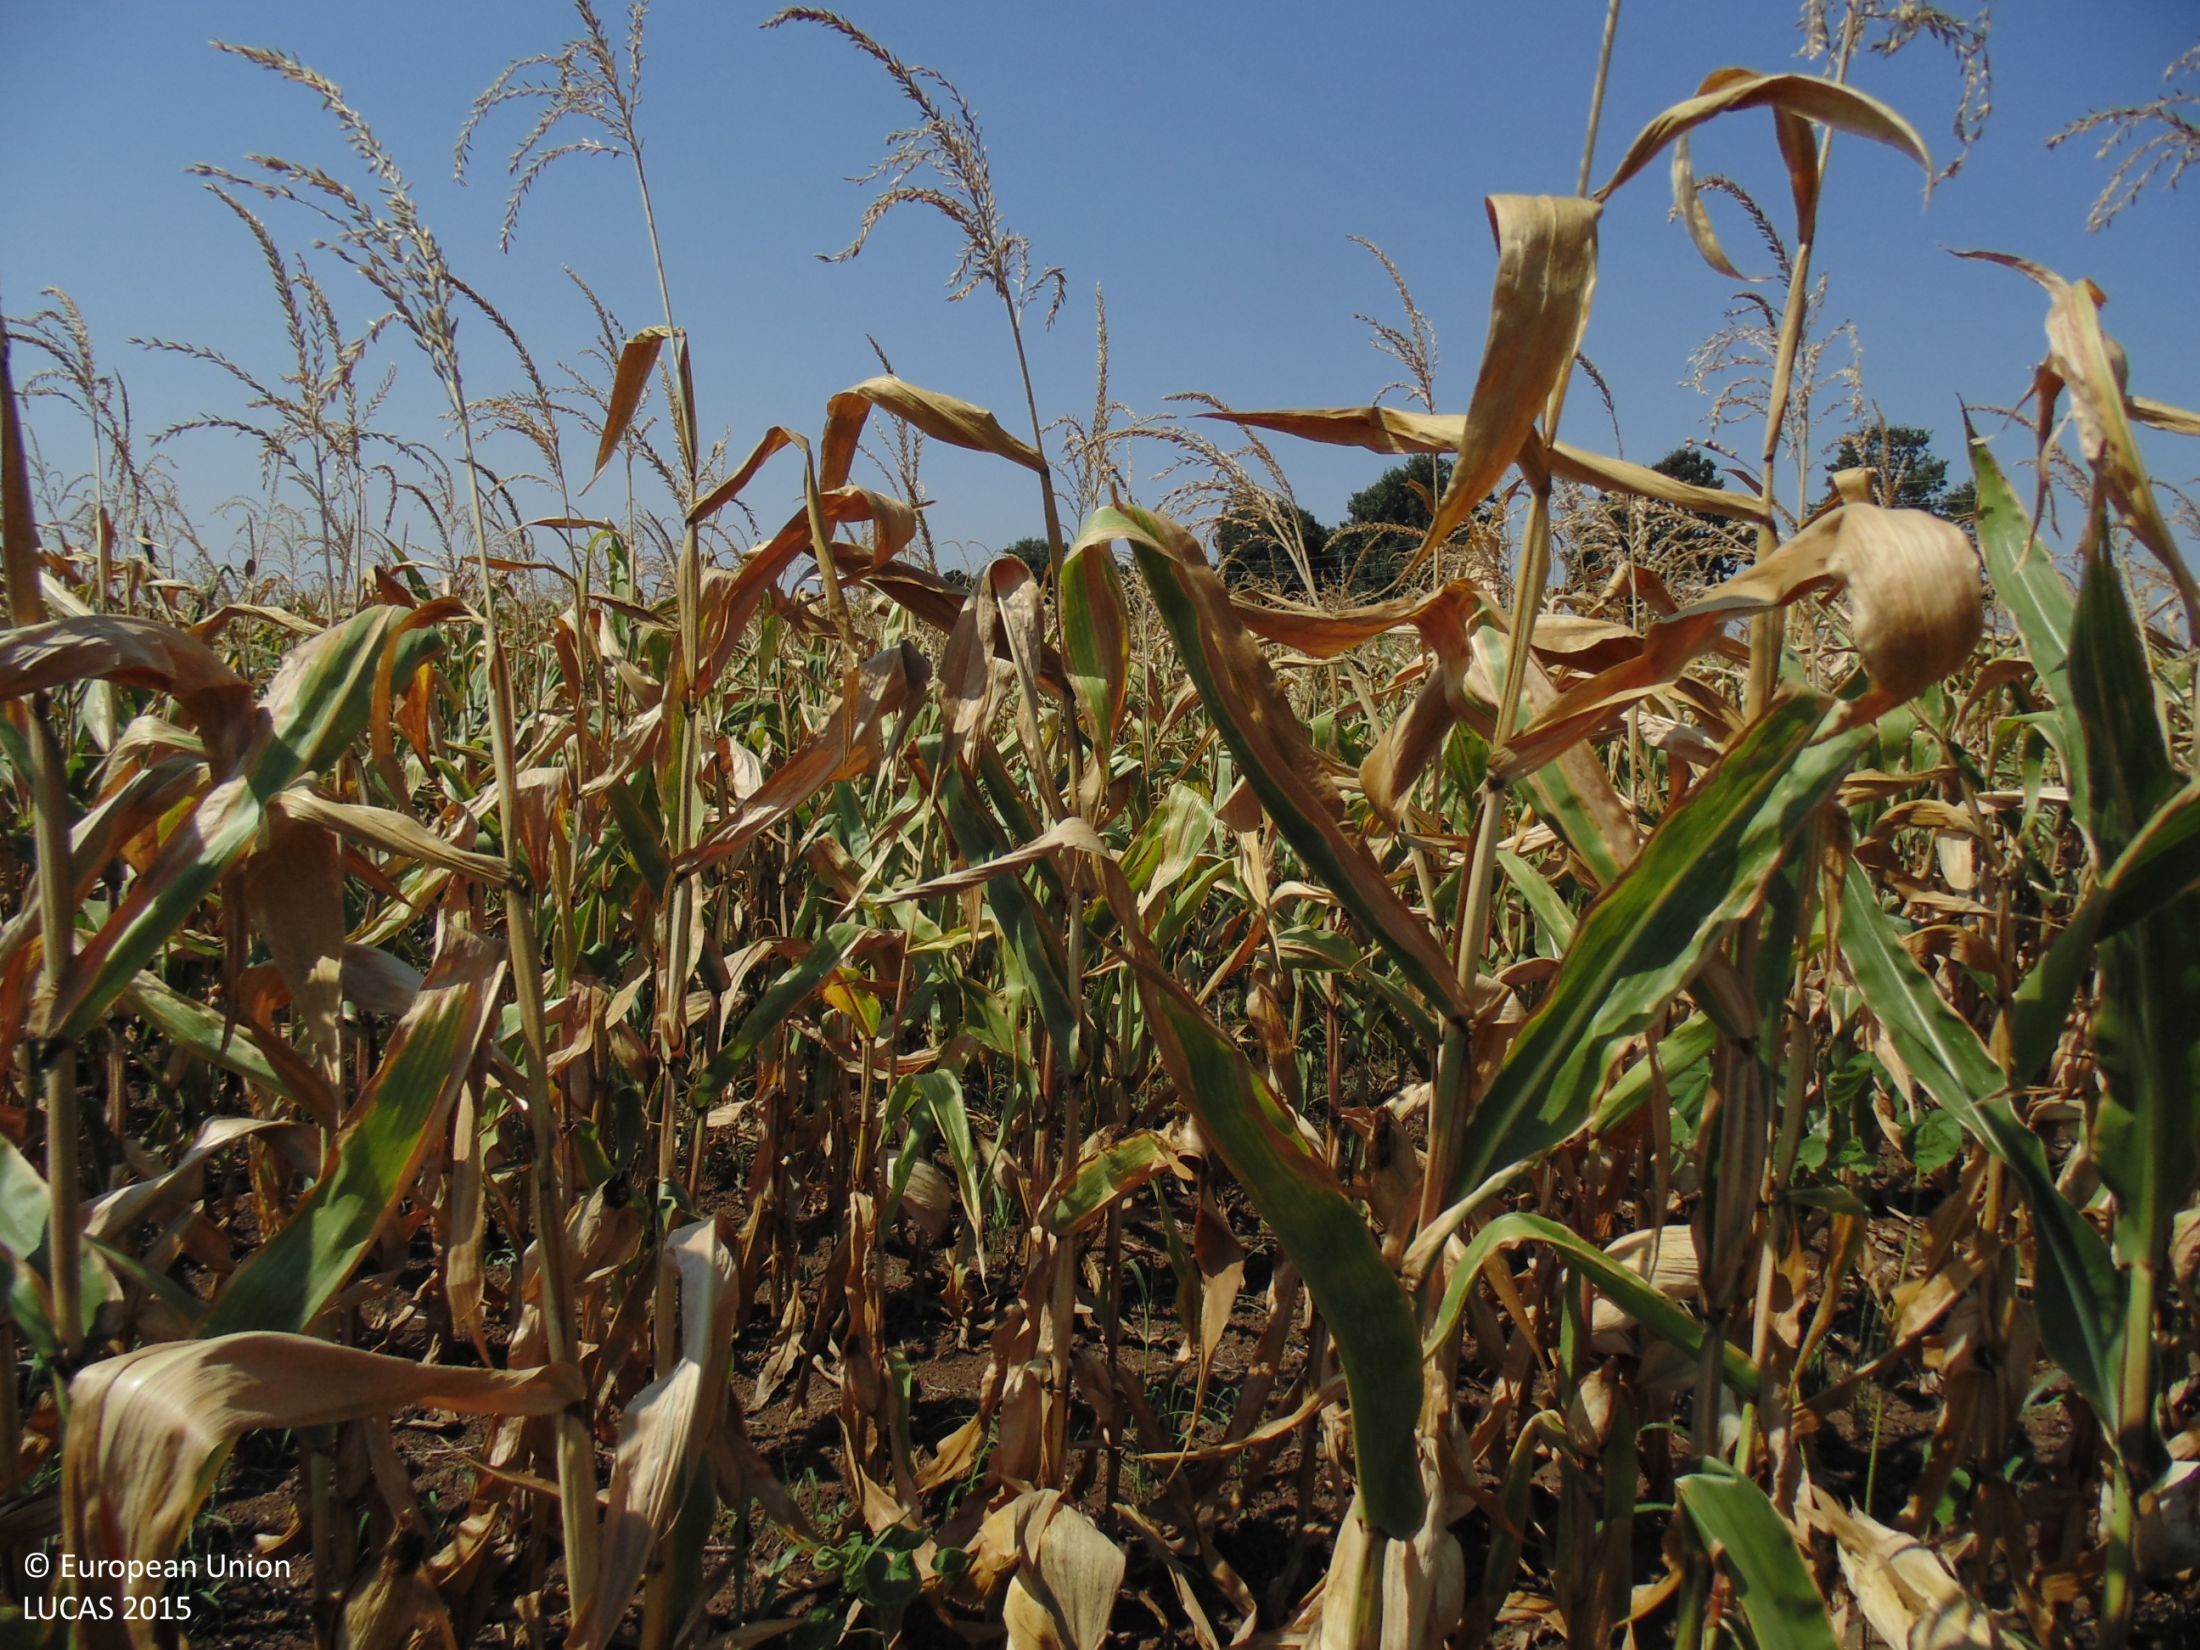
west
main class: Cropland
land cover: Maize
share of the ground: > 75 %
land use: Agriculture (excluding fallow land and kitchen gardens)
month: August
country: BG
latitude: 43.6889
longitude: 27.4383
